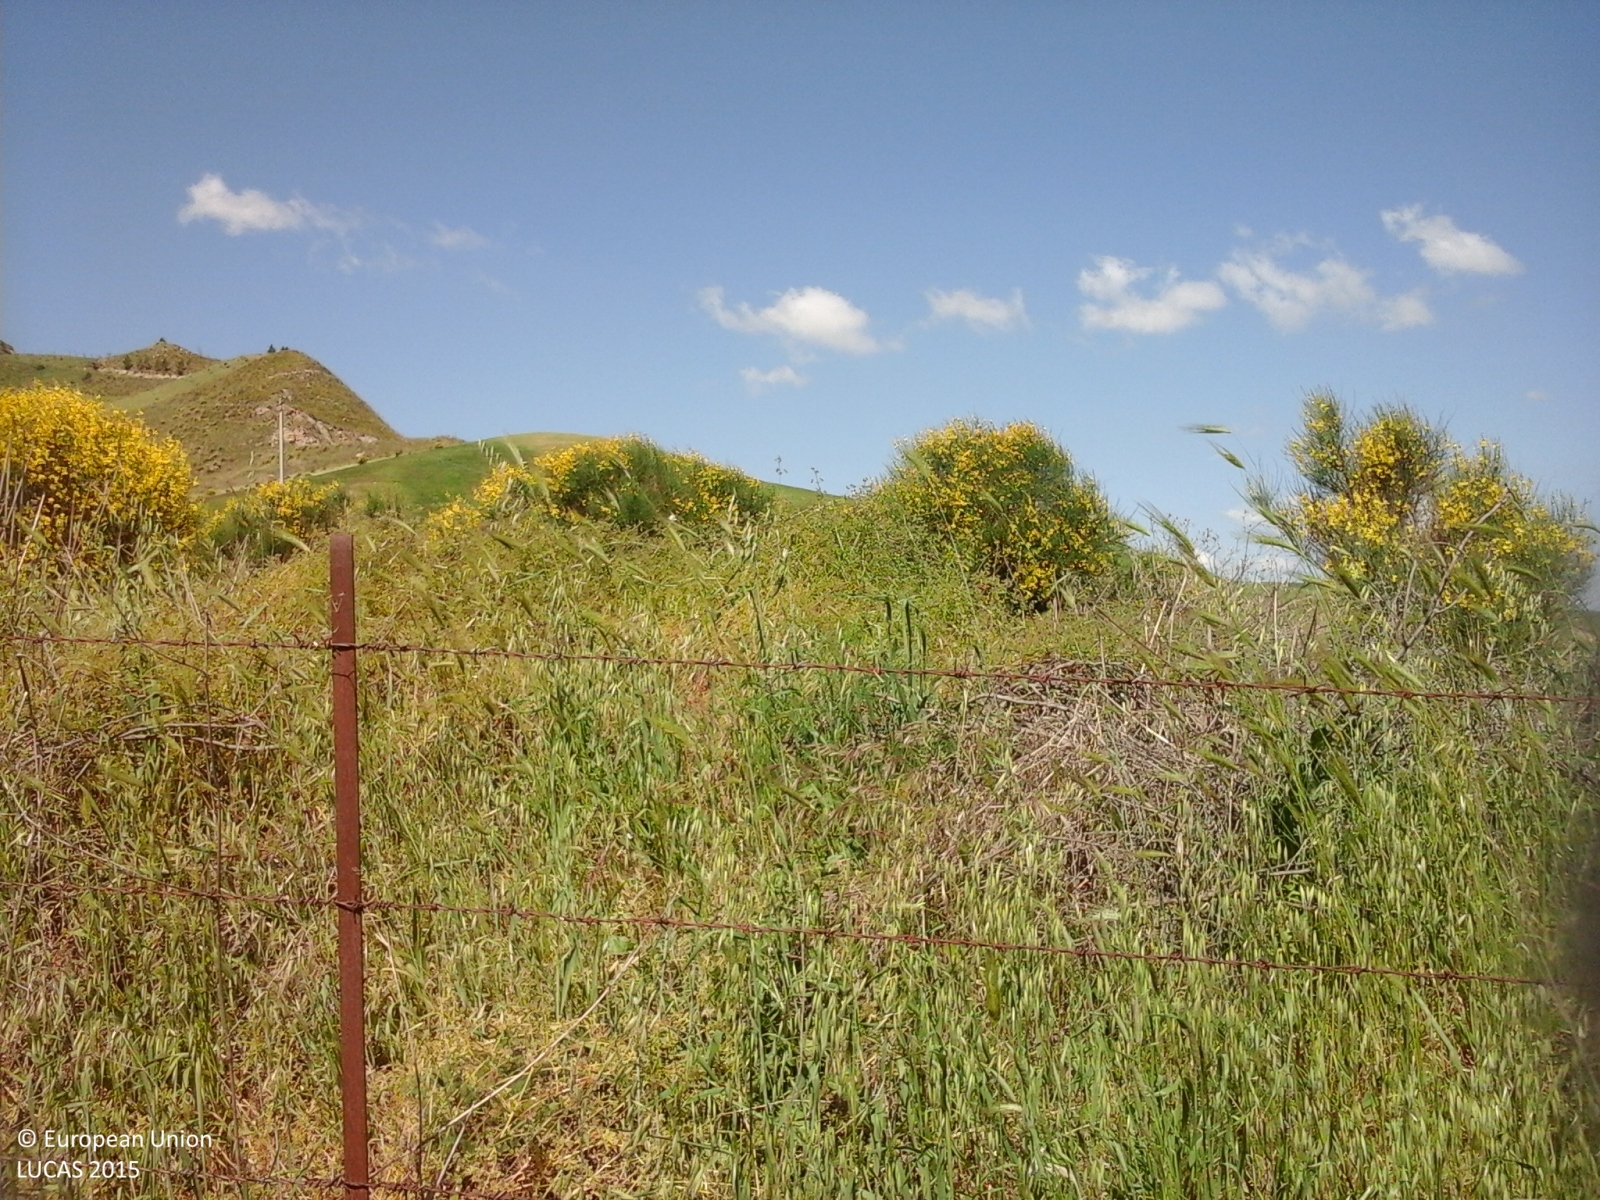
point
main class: Grassland
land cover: Grassland with sparse tree/shrub cover
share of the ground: > 75 %
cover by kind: herbaceous plants 90 %, coniferous forest trees 5 %, shrubs 5 %
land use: Agriculture (excluding fallow land and kitchen gardens)
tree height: < 5 m
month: May
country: IT
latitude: 37.6011
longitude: 13.7440
